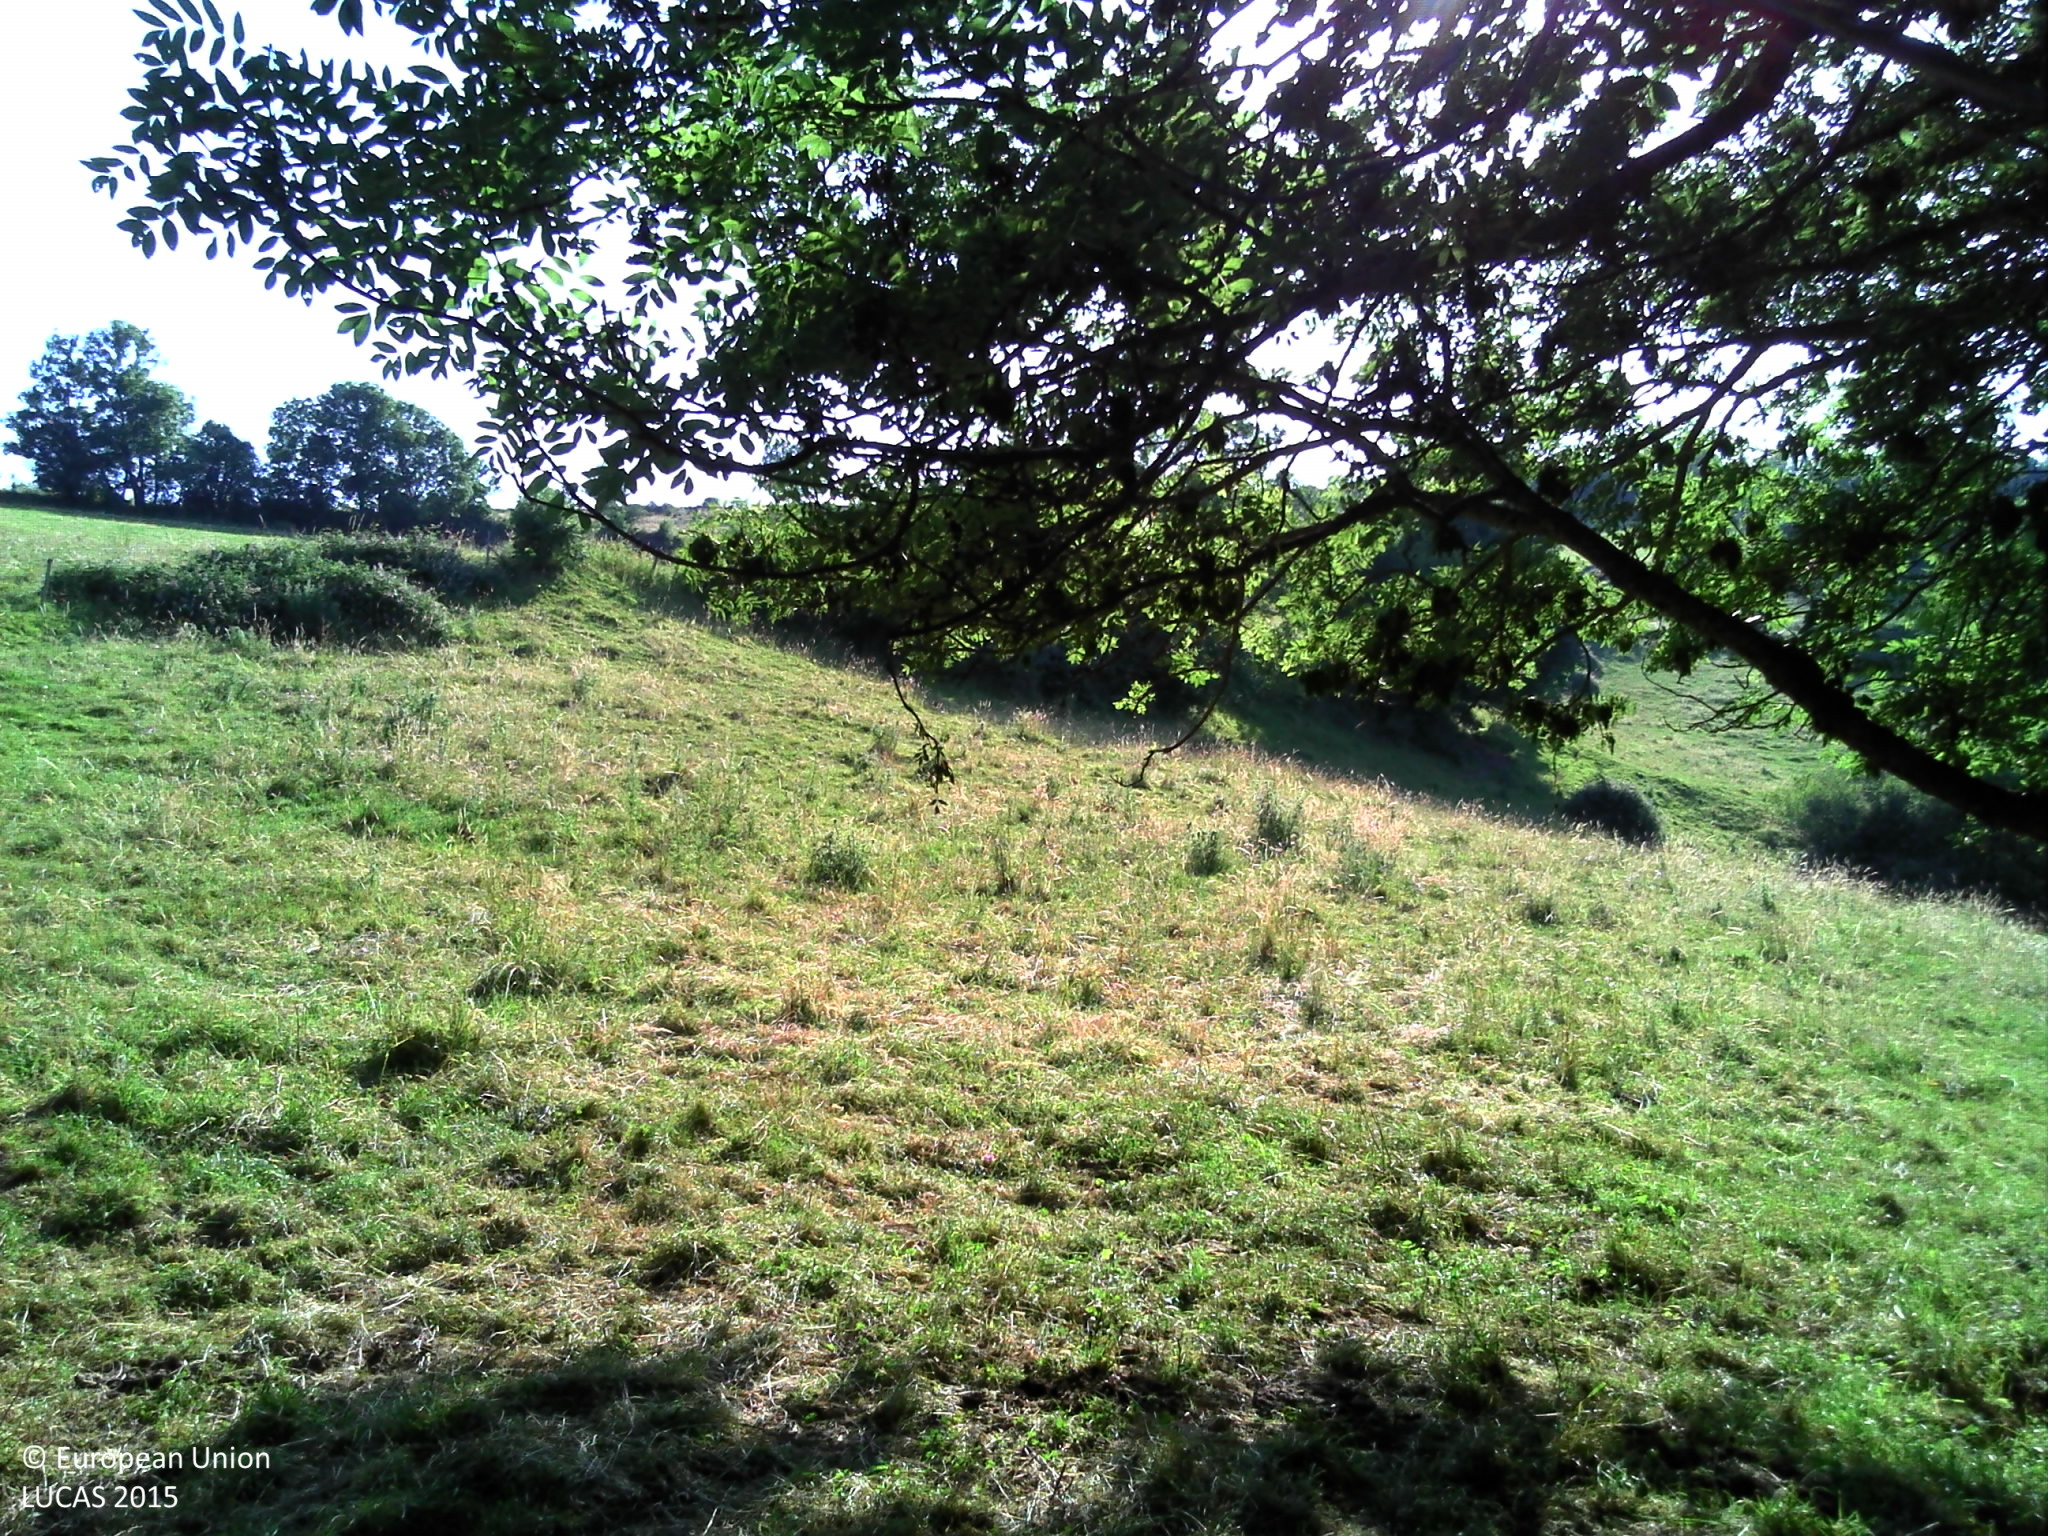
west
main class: Woodland
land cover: Broadleaved woodland
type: mesophytic deciduous forest
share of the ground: > 75 %
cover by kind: broadleaved forest trees 90 %, shrubs 5 %, herbaceous plants 5 %
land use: Forestry
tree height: > 5 m
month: July
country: FR
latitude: 45.4778
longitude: 3.1055
